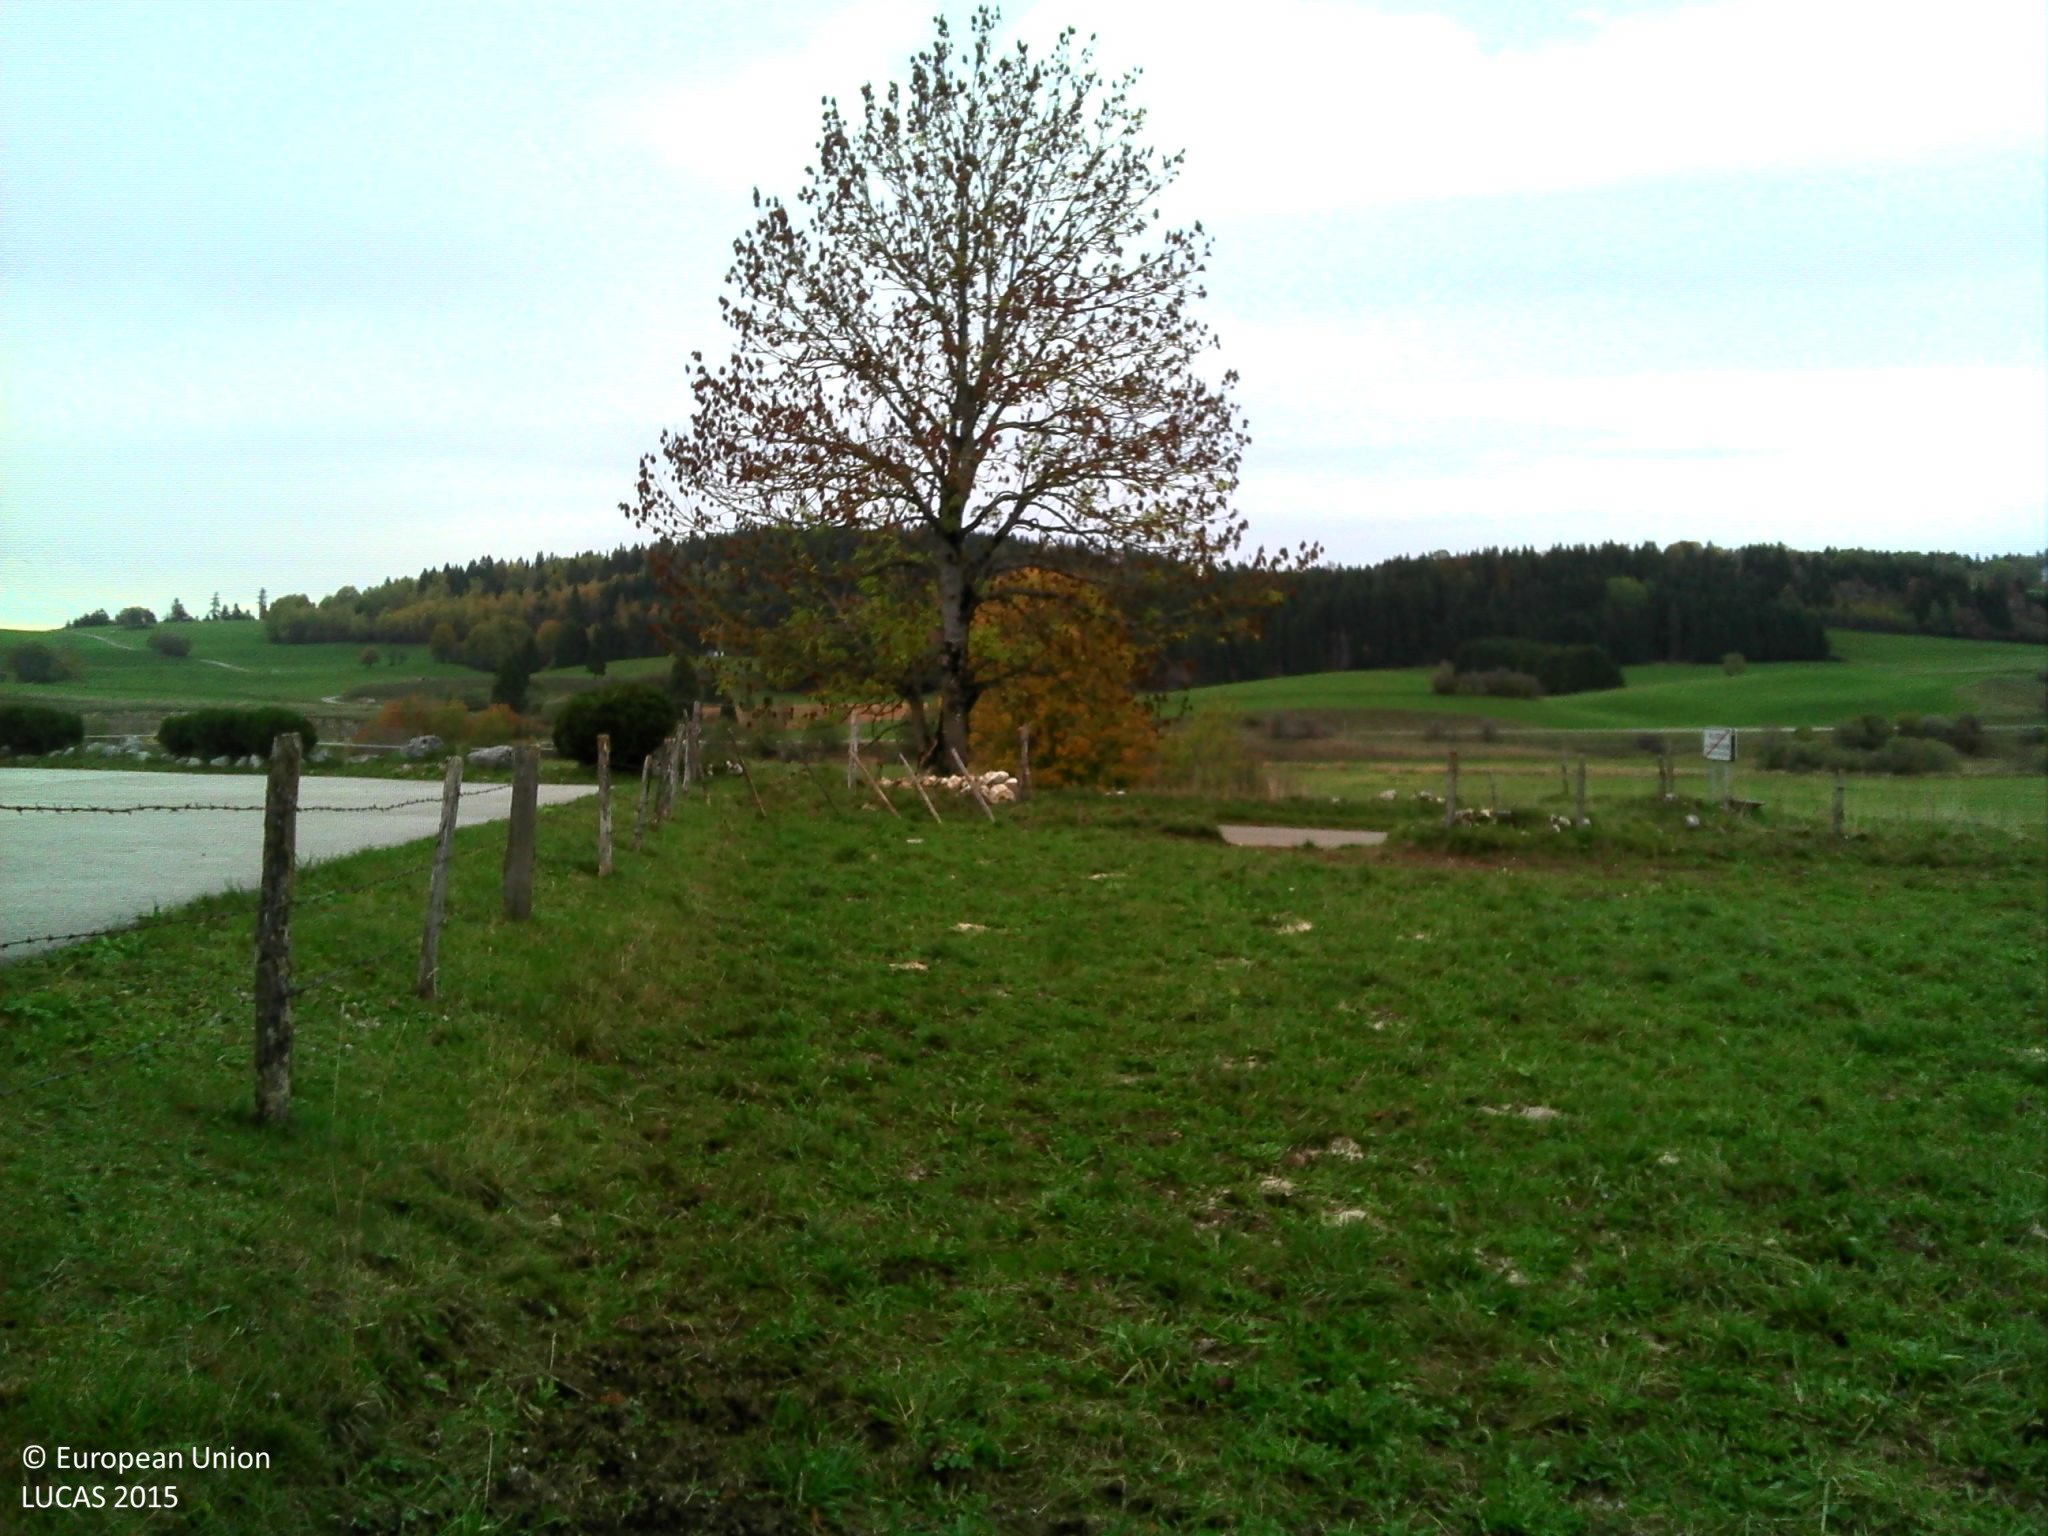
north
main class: Grassland
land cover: Grassland without tree/shrub cover
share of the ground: > 75 %
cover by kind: herbaceous plants 100 %
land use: Agriculture (excluding fallow land and kitchen gardens)
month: October
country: FR
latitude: 46.7370
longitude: 6.2728
